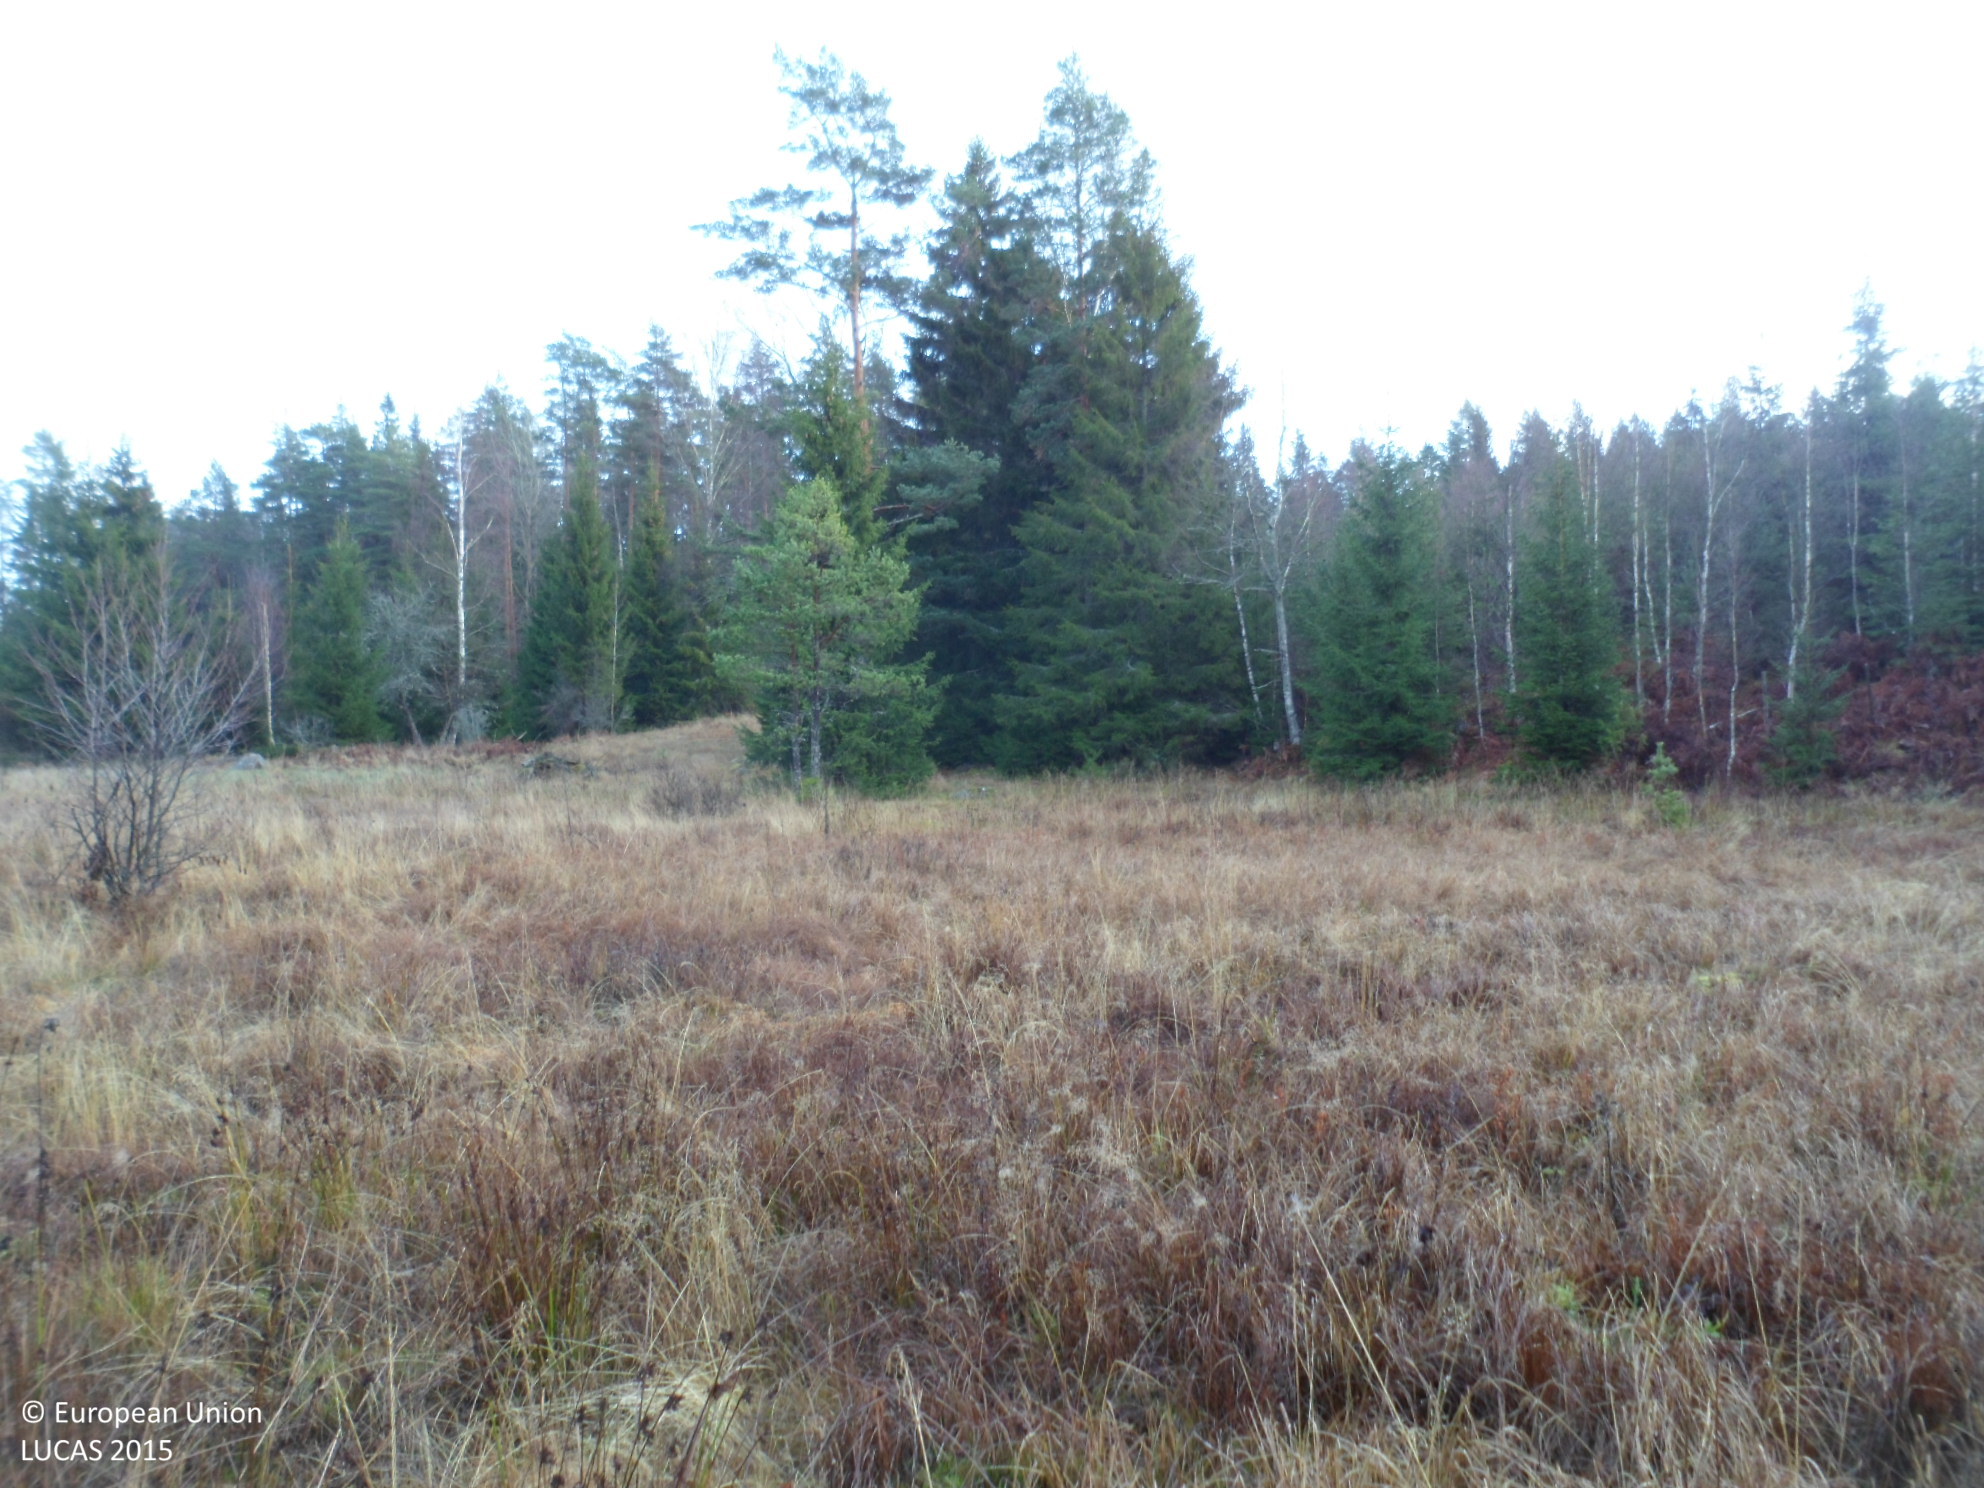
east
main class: Grassland
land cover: Grassland without tree/shrub cover
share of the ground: > 75 %
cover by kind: herbaceous plants 90 %, lichens and mosses 10 %
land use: Agriculture (excluding fallow land and kitchen gardens)
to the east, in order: Grassland without tree/shrub cover; Pine dominated coniferous woodland; Grassland without tree/shrub cover; Pine dominated coniferous woodland; Grassland with sparse tree/shrub cover; Spruce dominated mixed woodland; Fences; Spruce dominated mixed woodland; Ditches and canals; Paved roads, cycling and walking lanes; Ditches and canals; Electric lines; Spruce dominated mixed woodland; Grassland without tree/shrub cover; Ditches and canals; Grassland without tree/shrub cover
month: November
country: SE
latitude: 57.5461
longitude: 15.9625
